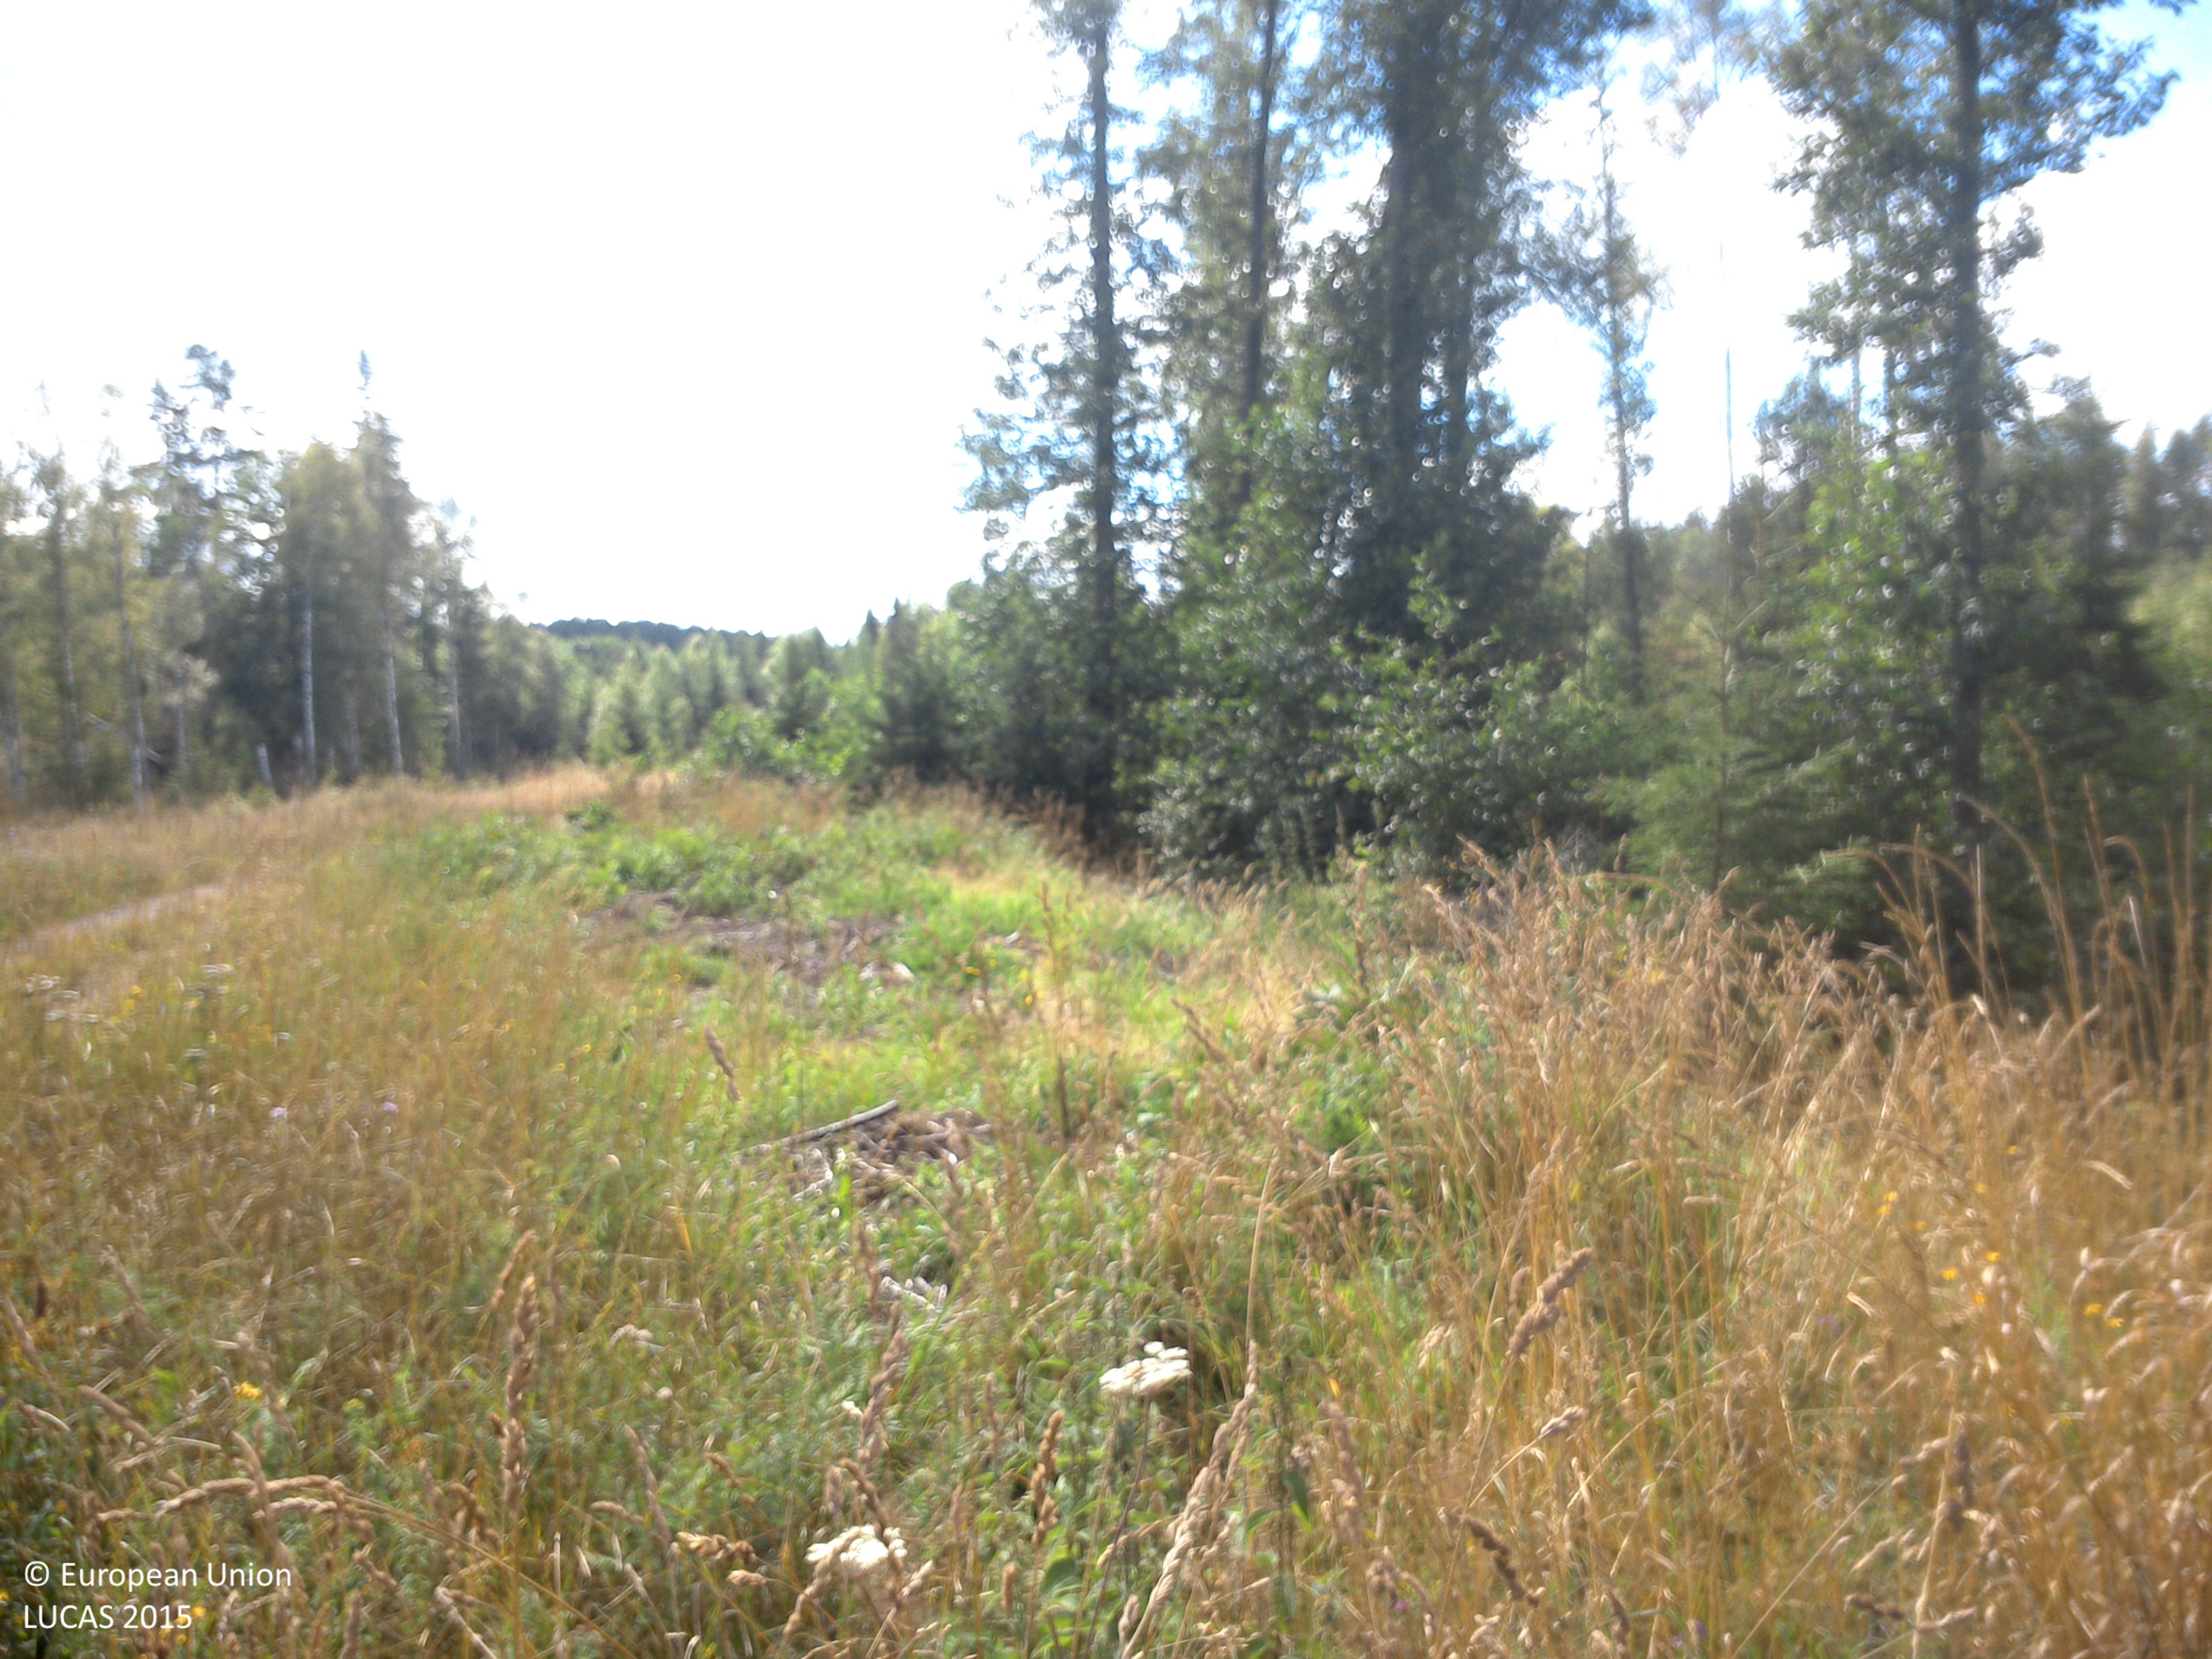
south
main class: Grassland
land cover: Grassland without tree/shrub cover
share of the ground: > 75 %
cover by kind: herbaceous plants 100 %
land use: Semi-natural and natural areas not in use
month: August
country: SE
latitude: 58.0762
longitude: 15.3700
